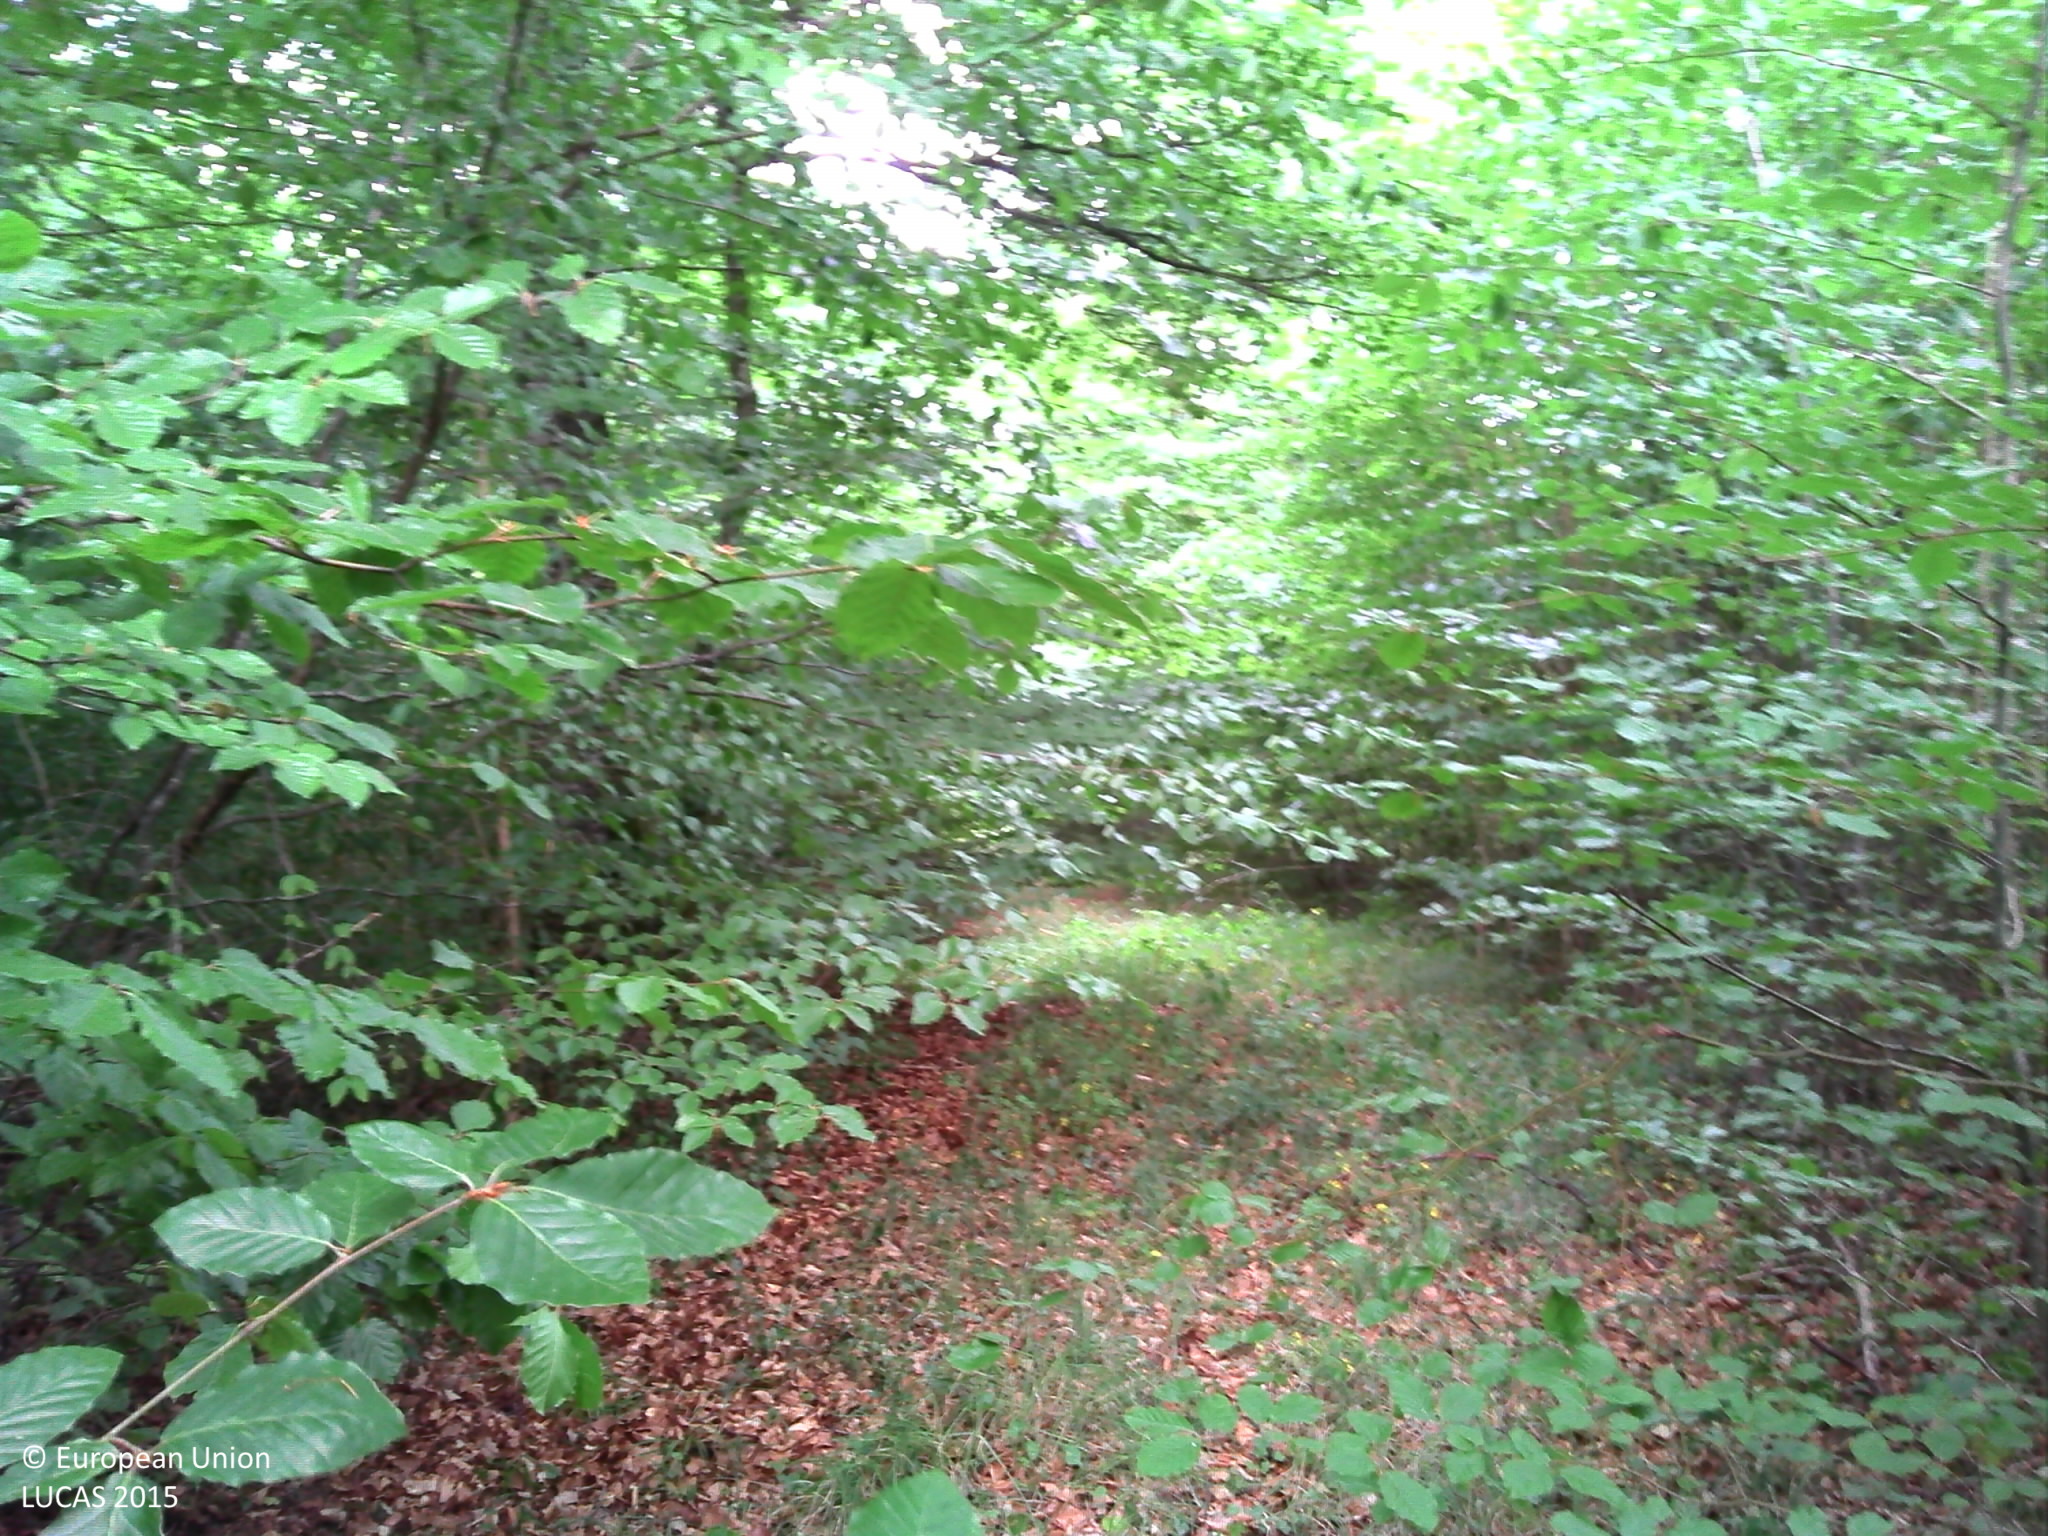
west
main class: Woodland
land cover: Broadleaved woodland
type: beech forest
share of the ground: > 75 %
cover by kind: broadleaved forest trees 80 %, herbaceous plants 10 %, shrubs 5 %, lichens and mosses 5 %
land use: Forestry
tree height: > 5 m
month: July
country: FR
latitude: 47.8296
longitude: 5.1773
